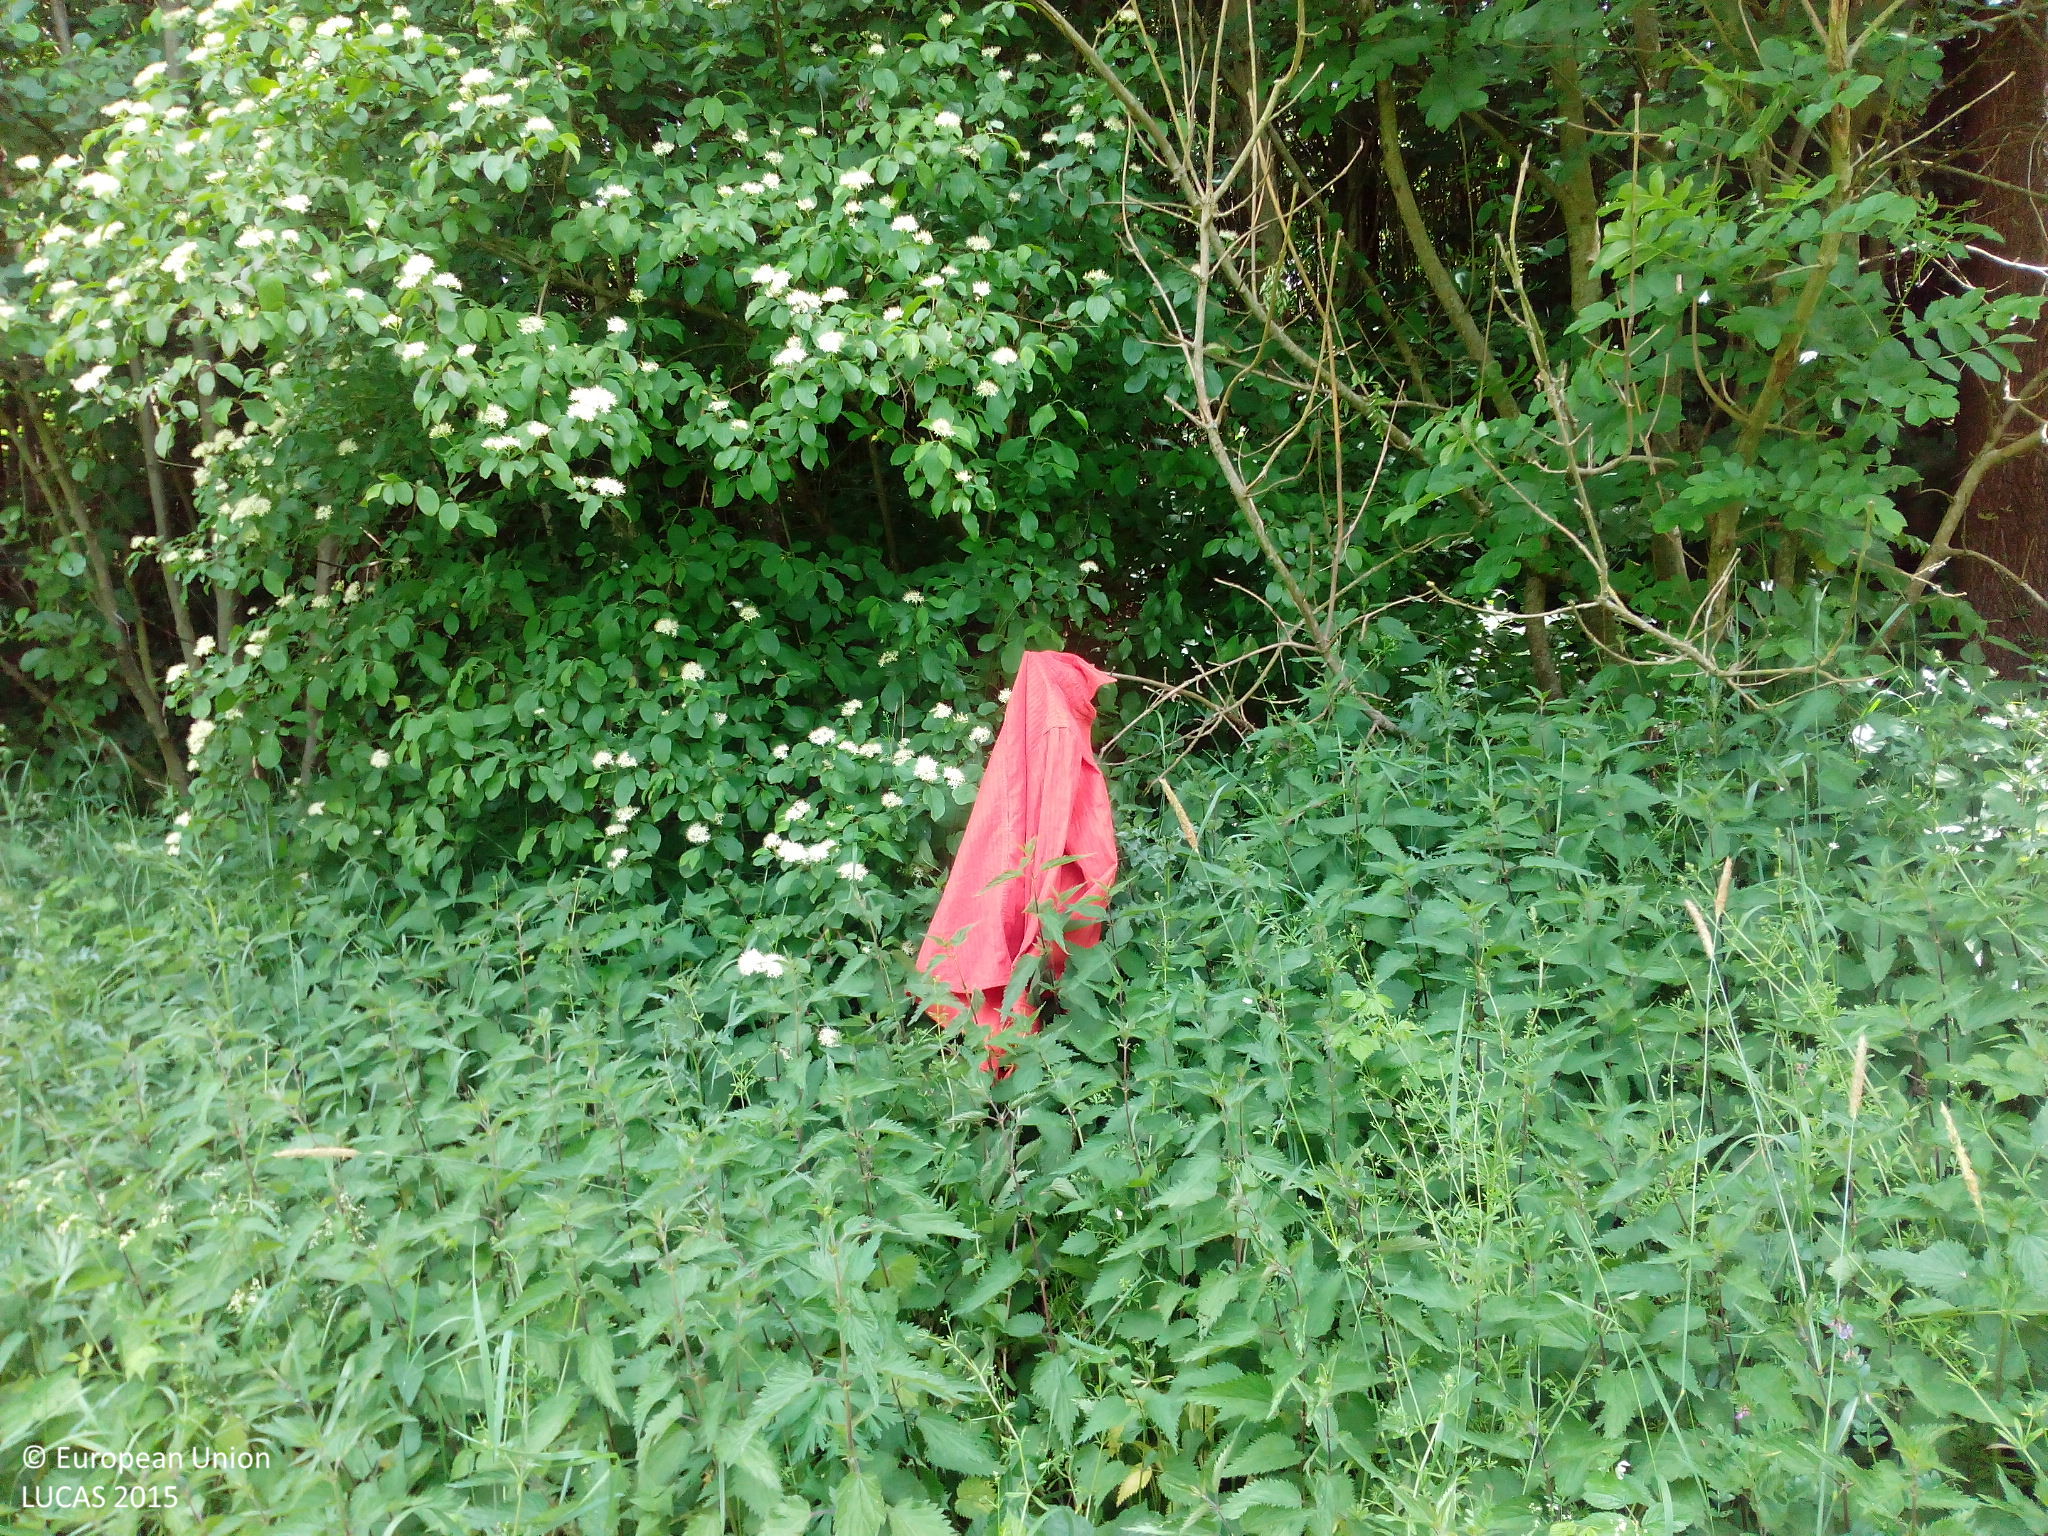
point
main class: Grassland
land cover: Grassland without tree/shrub cover
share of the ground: > 75 %
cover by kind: herbaceous plants 100 %
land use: Agriculture (excluding fallow land and kitchen gardens)
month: June
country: DE
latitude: 49.1391
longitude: 9.3286
